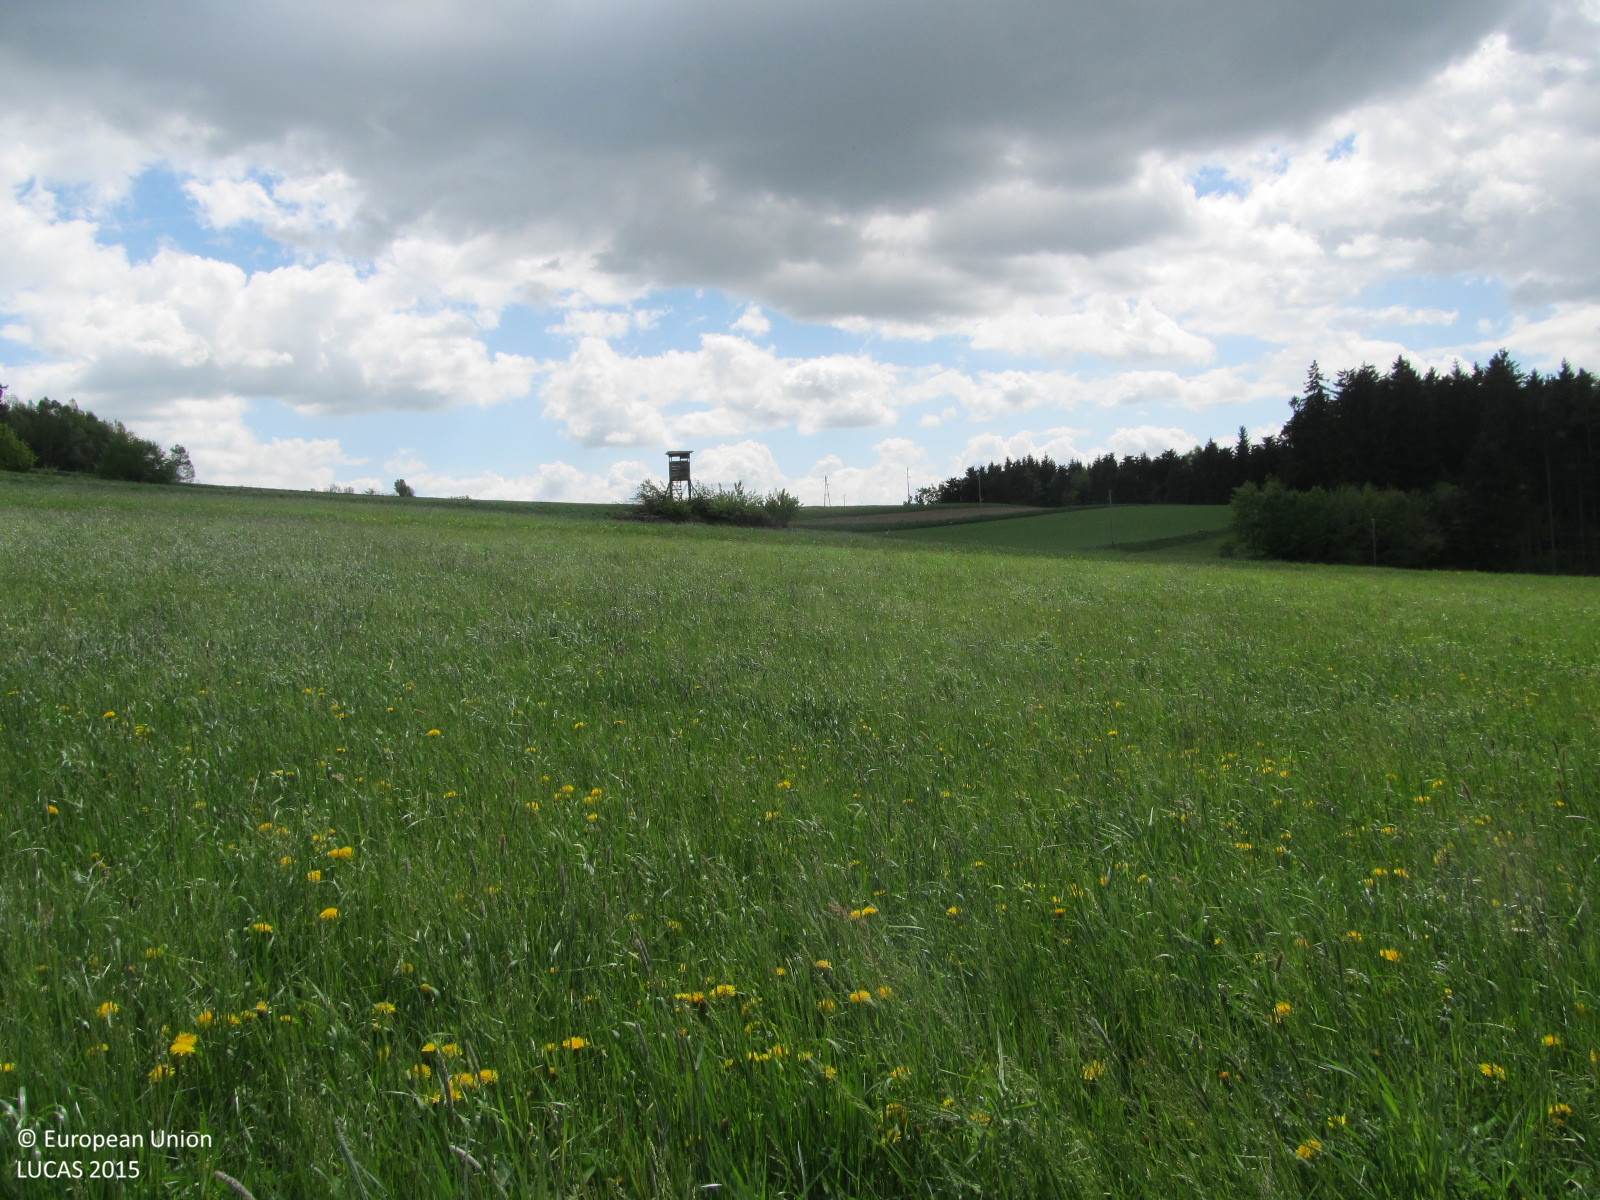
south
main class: Grassland
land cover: Grassland without tree/shrub cover
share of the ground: > 75 %
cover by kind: herbaceous plants 100 %
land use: Agriculture (excluding fallow land and kitchen gardens)
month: May
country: AT
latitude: 48.5277
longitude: 15.3240
